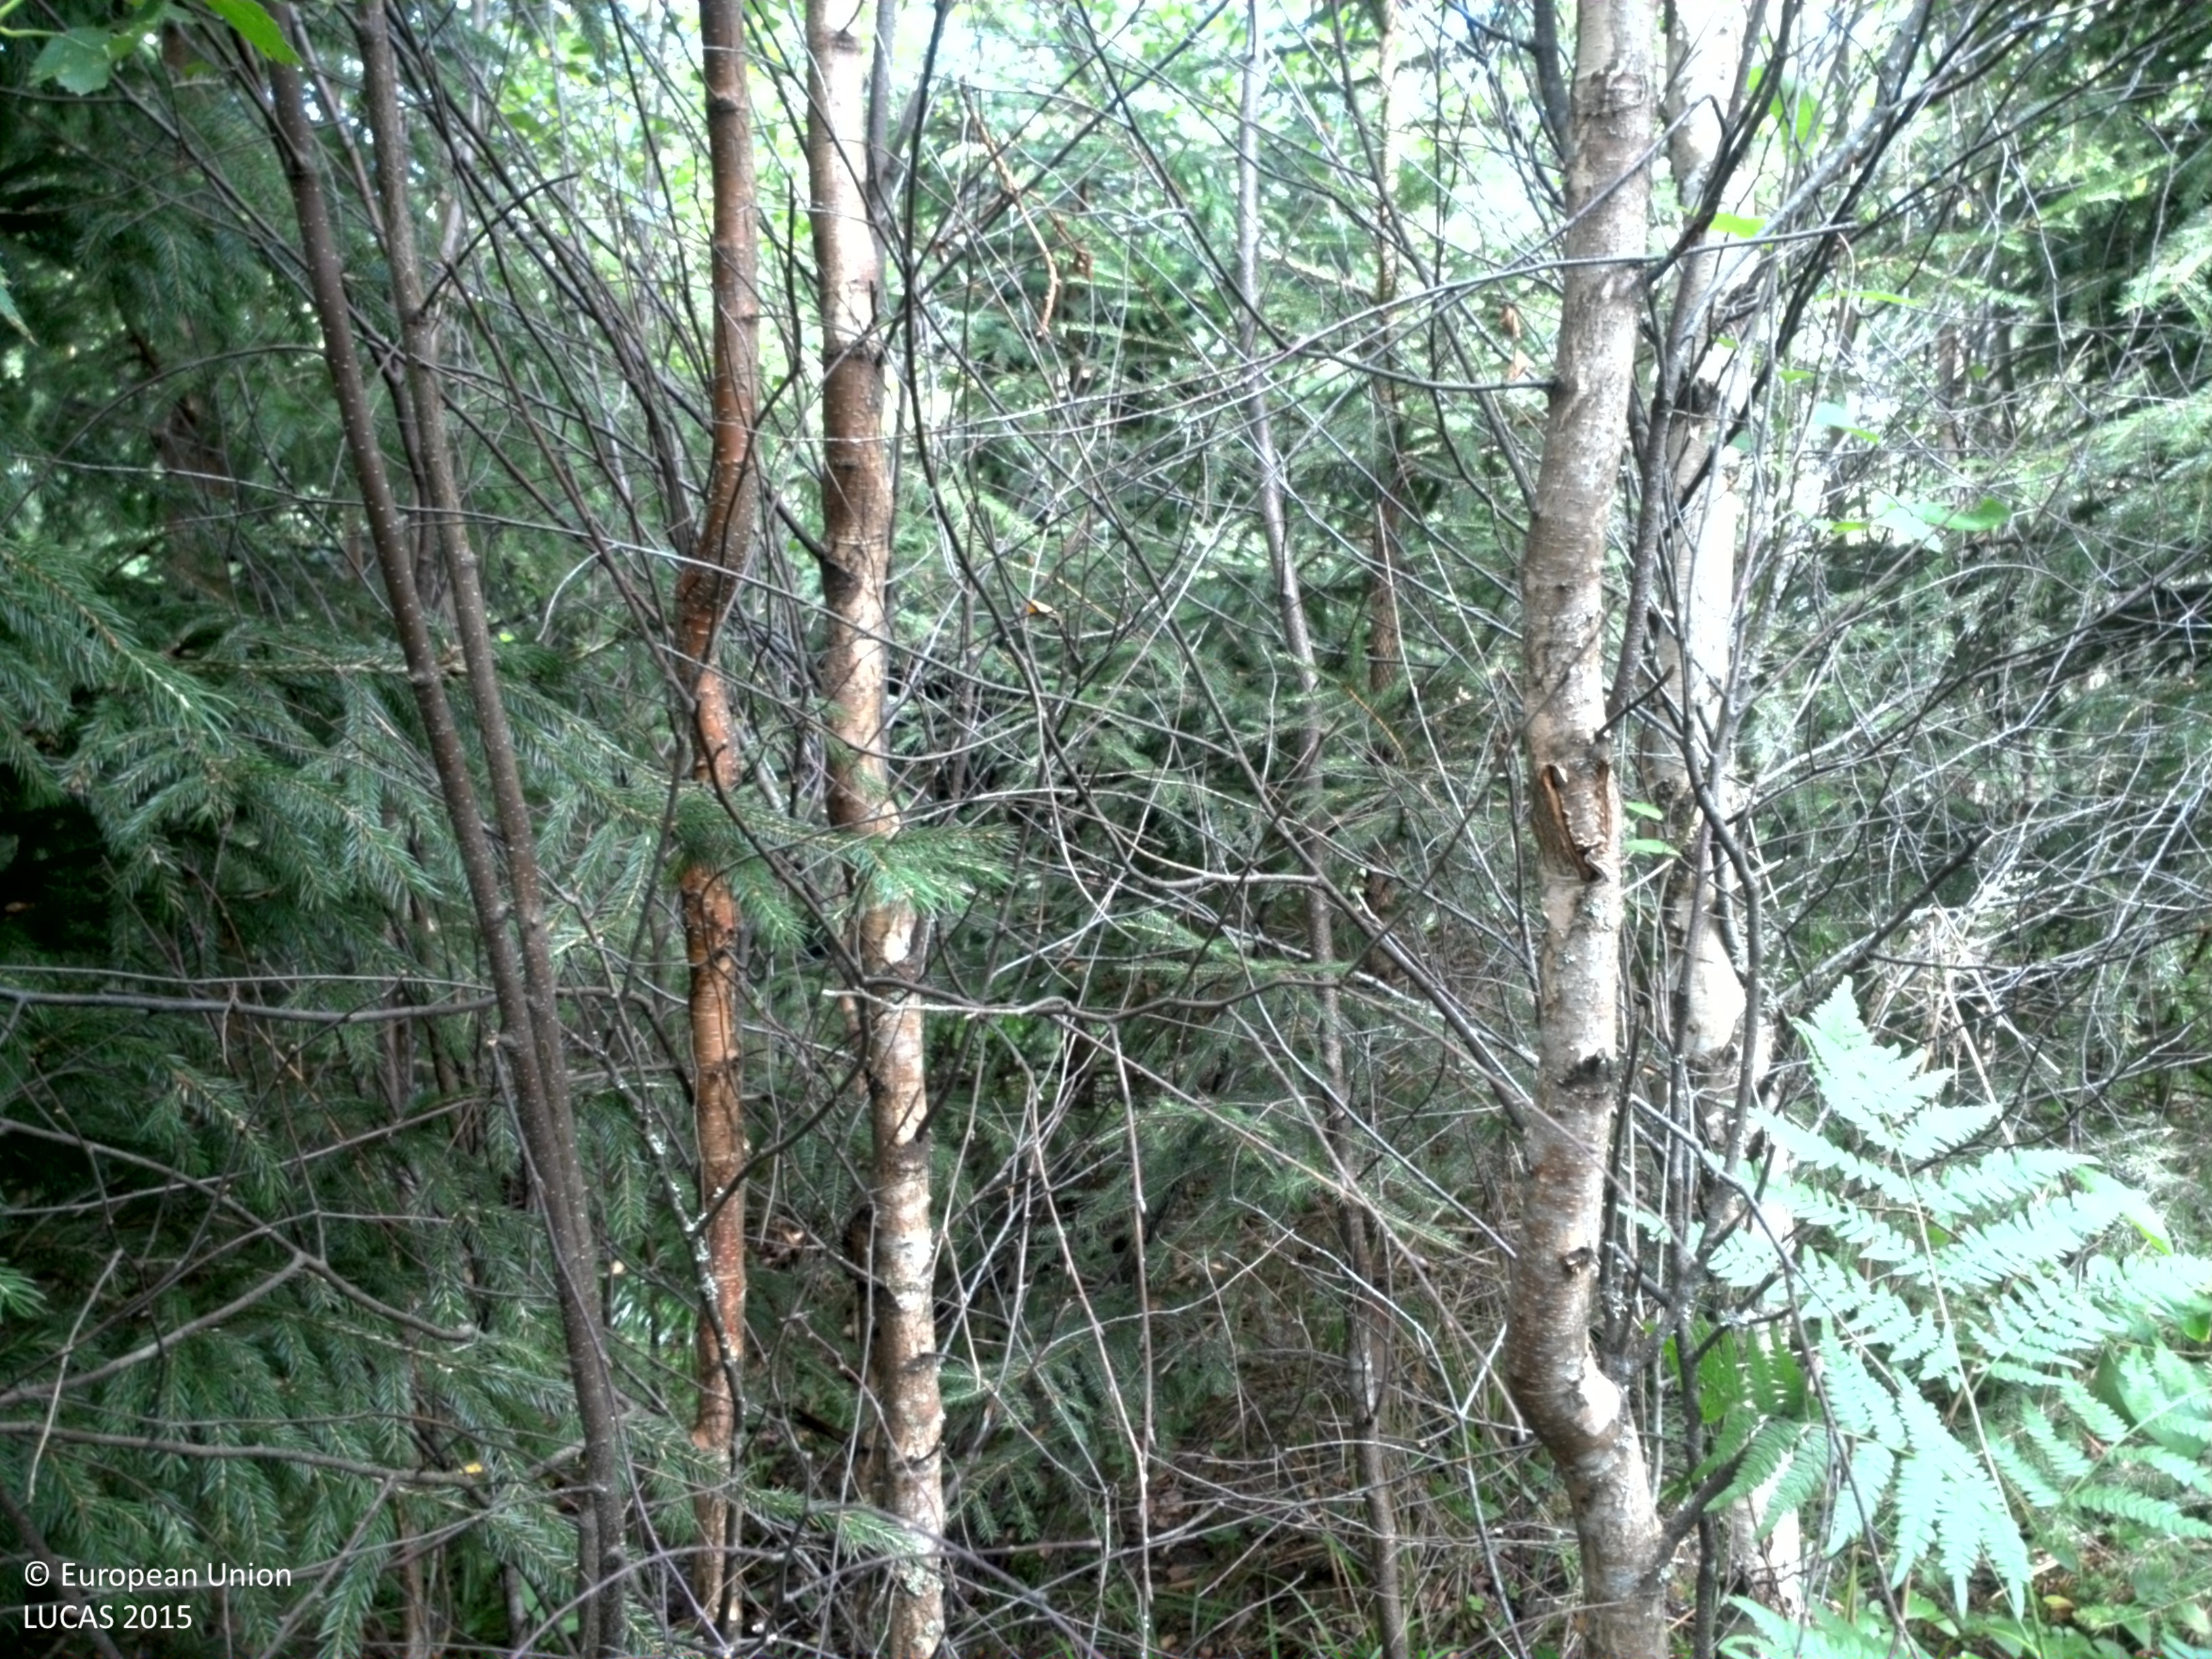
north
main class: Woodland
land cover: Spruce dominated mixed woodland
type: boreal forest
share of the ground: 50 - 75 %
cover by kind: coniferous forest trees 40 %, broadleaved forest trees 25 %, herbaceous plants 20 %, lichens and mosses 10 %, shrubs 5 %
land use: Forestry
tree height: < 5 m
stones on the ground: < 10 %
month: July
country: SE
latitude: 59.4659
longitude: 11.8832
